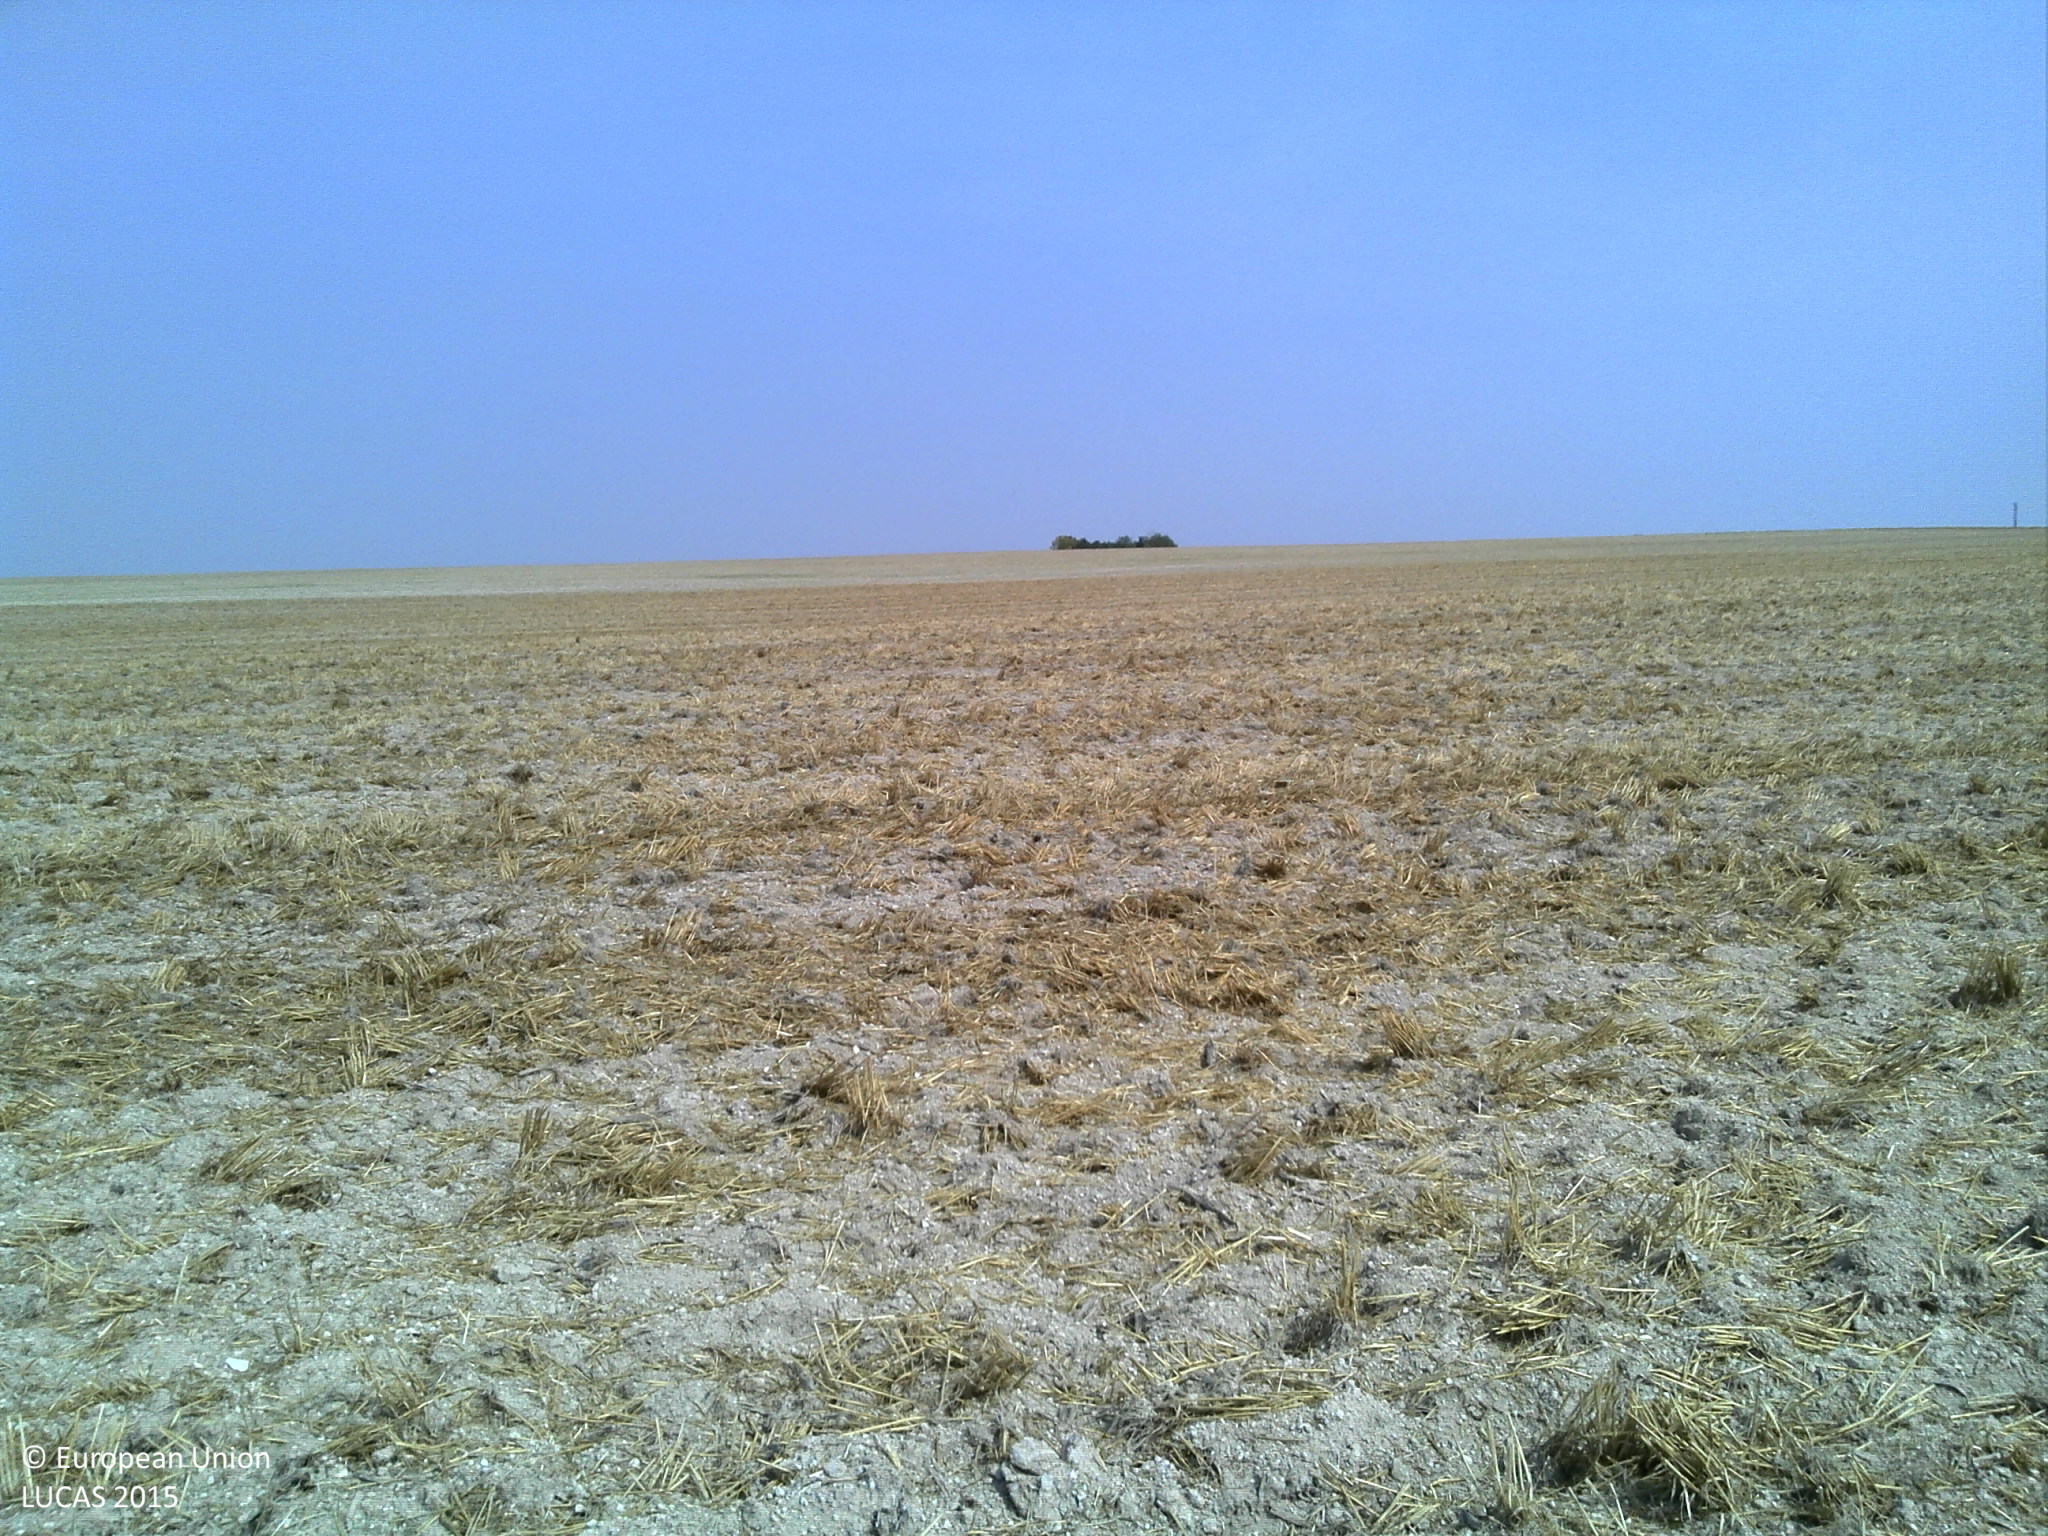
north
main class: Cropland
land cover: Common wheat
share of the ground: > 75 %
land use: Agriculture (excluding fallow land and kitchen gardens)
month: August
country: FR
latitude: 49.0492
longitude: 4.6472
